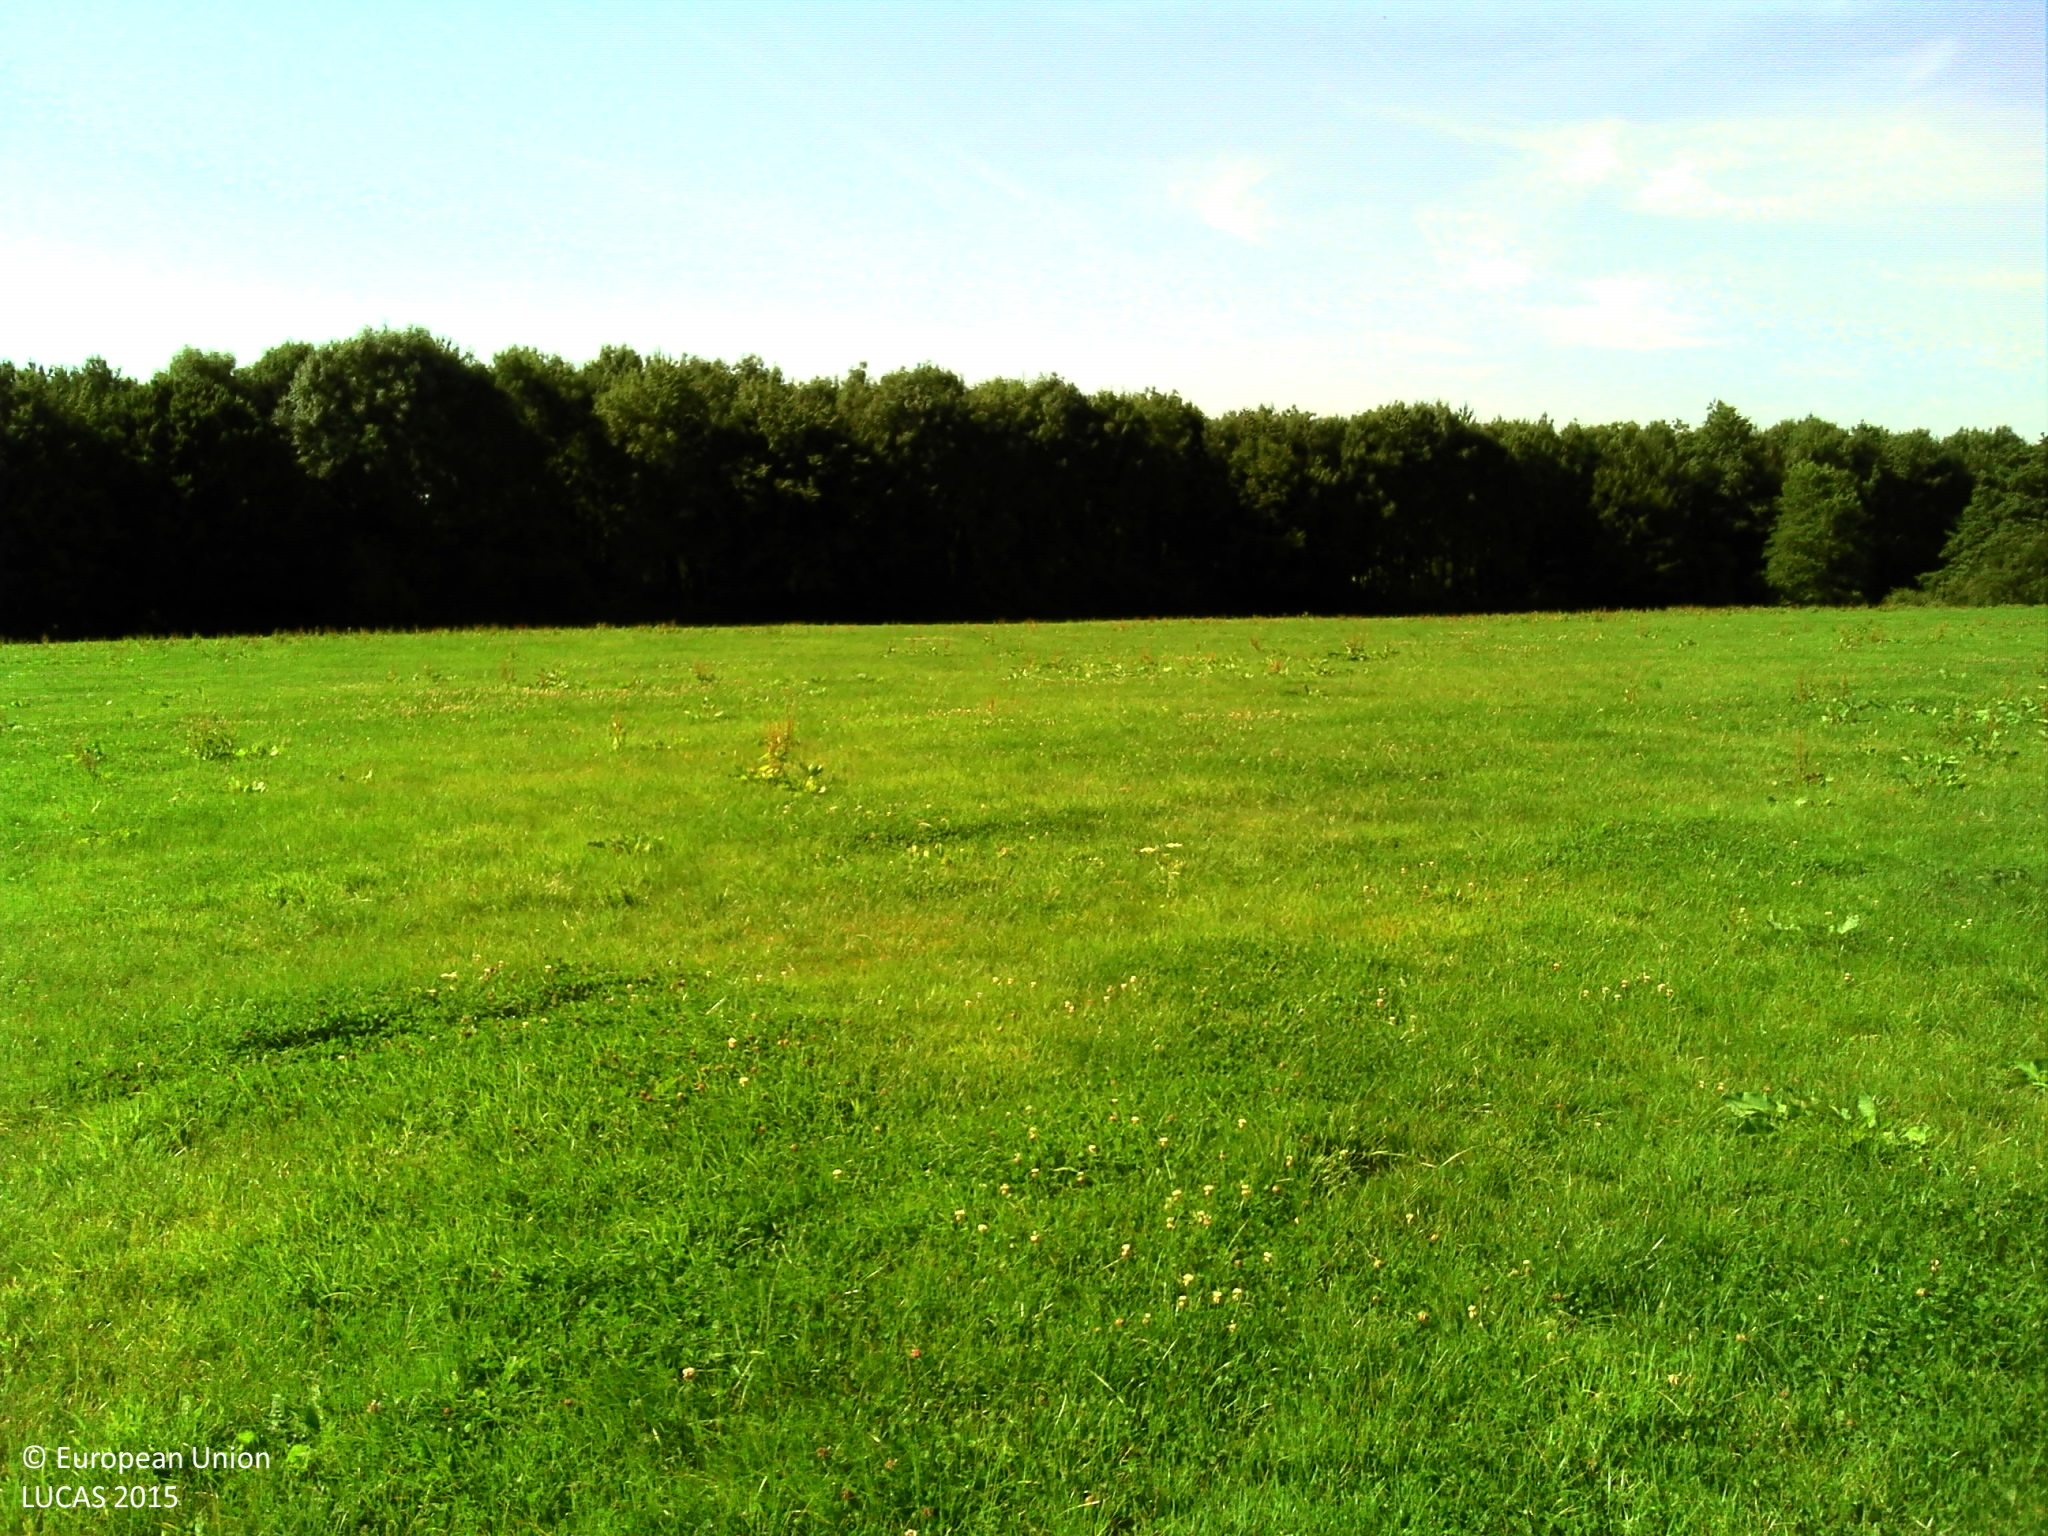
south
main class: Grassland
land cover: Grassland without tree/shrub cover
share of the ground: > 75 %
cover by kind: herbaceous plants 100 %
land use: Agriculture (excluding fallow land and kitchen gardens)
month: August
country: FR
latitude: 50.1534
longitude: 4.0182
